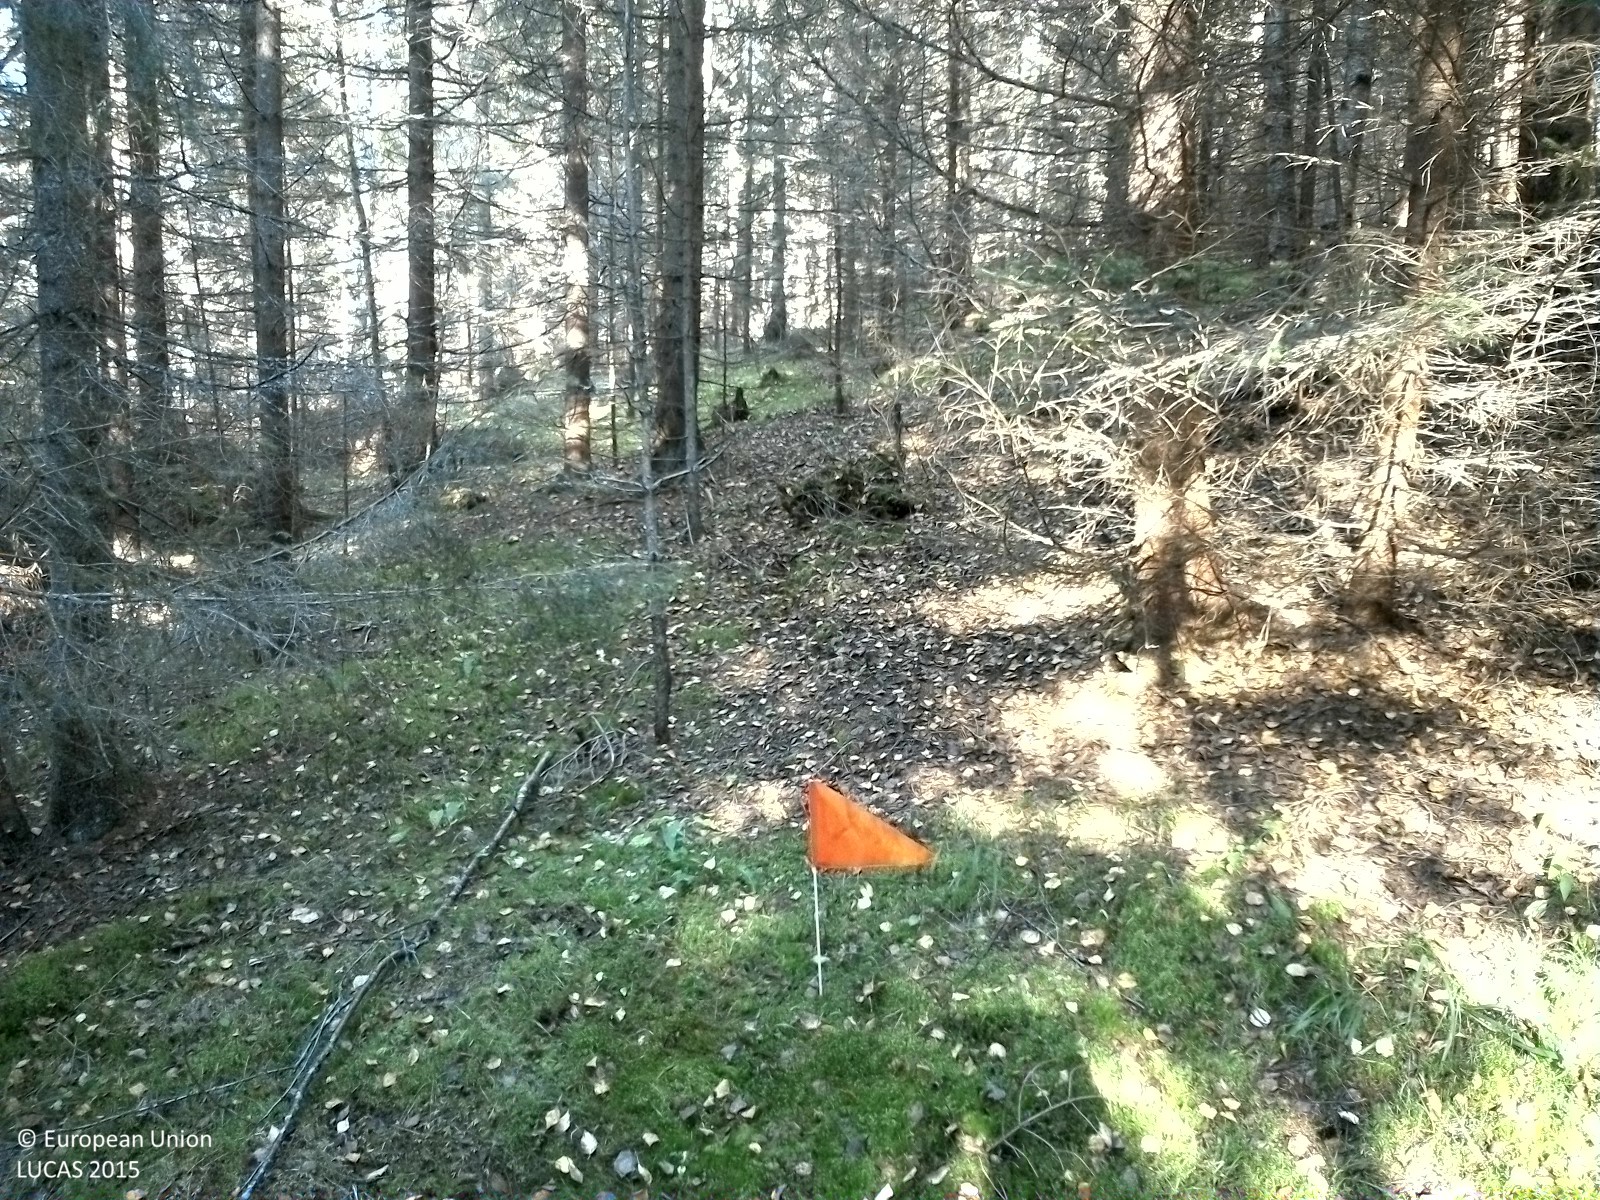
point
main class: Woodland
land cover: Spruce dominated coniferous woodland
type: boreal forest
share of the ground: > 75 %
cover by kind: coniferous forest trees 80 %, broadleaved forest trees 10 %, shrubs 10 %
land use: Forestry
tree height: > 5 m
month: September
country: SE
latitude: 62.2946
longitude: 17.2109
